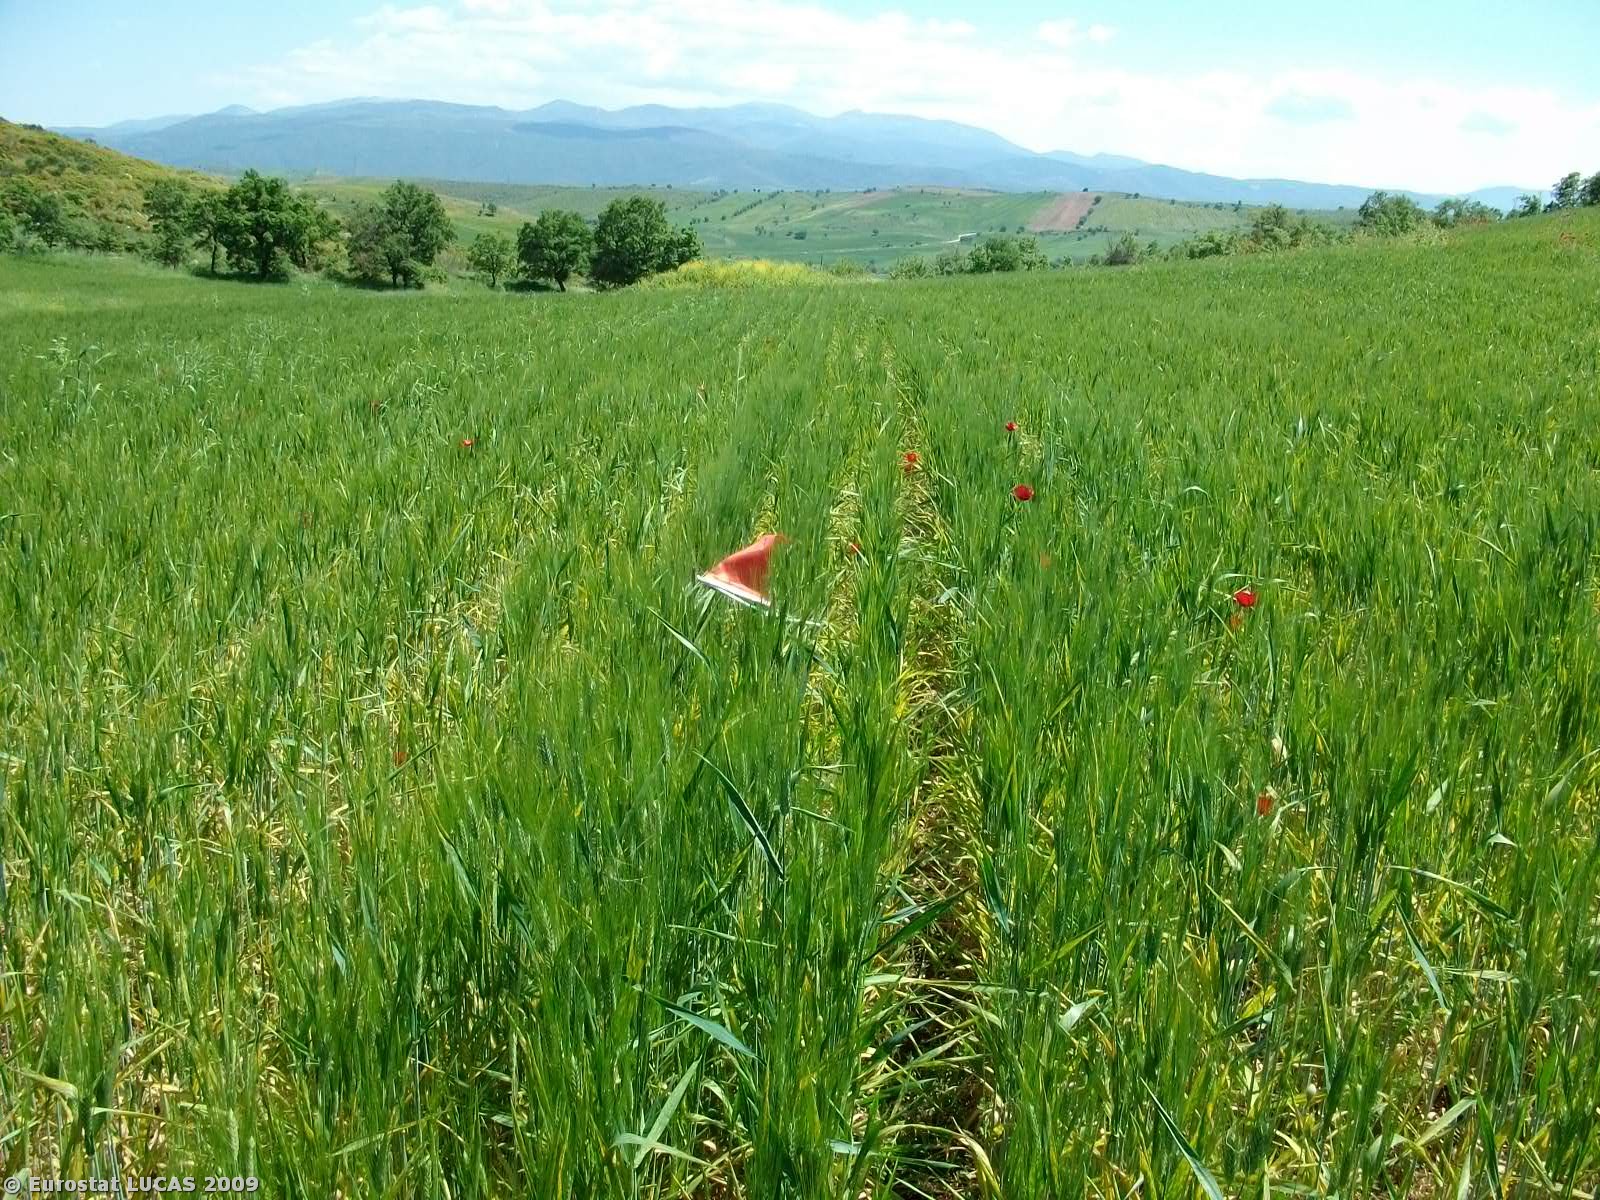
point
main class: Cropland
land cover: Durum wheat
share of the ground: > 75 %
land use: Agriculture (excluding fallow land and kitchen gardens)
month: May
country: GR
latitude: 39.2138
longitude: 22.4583
